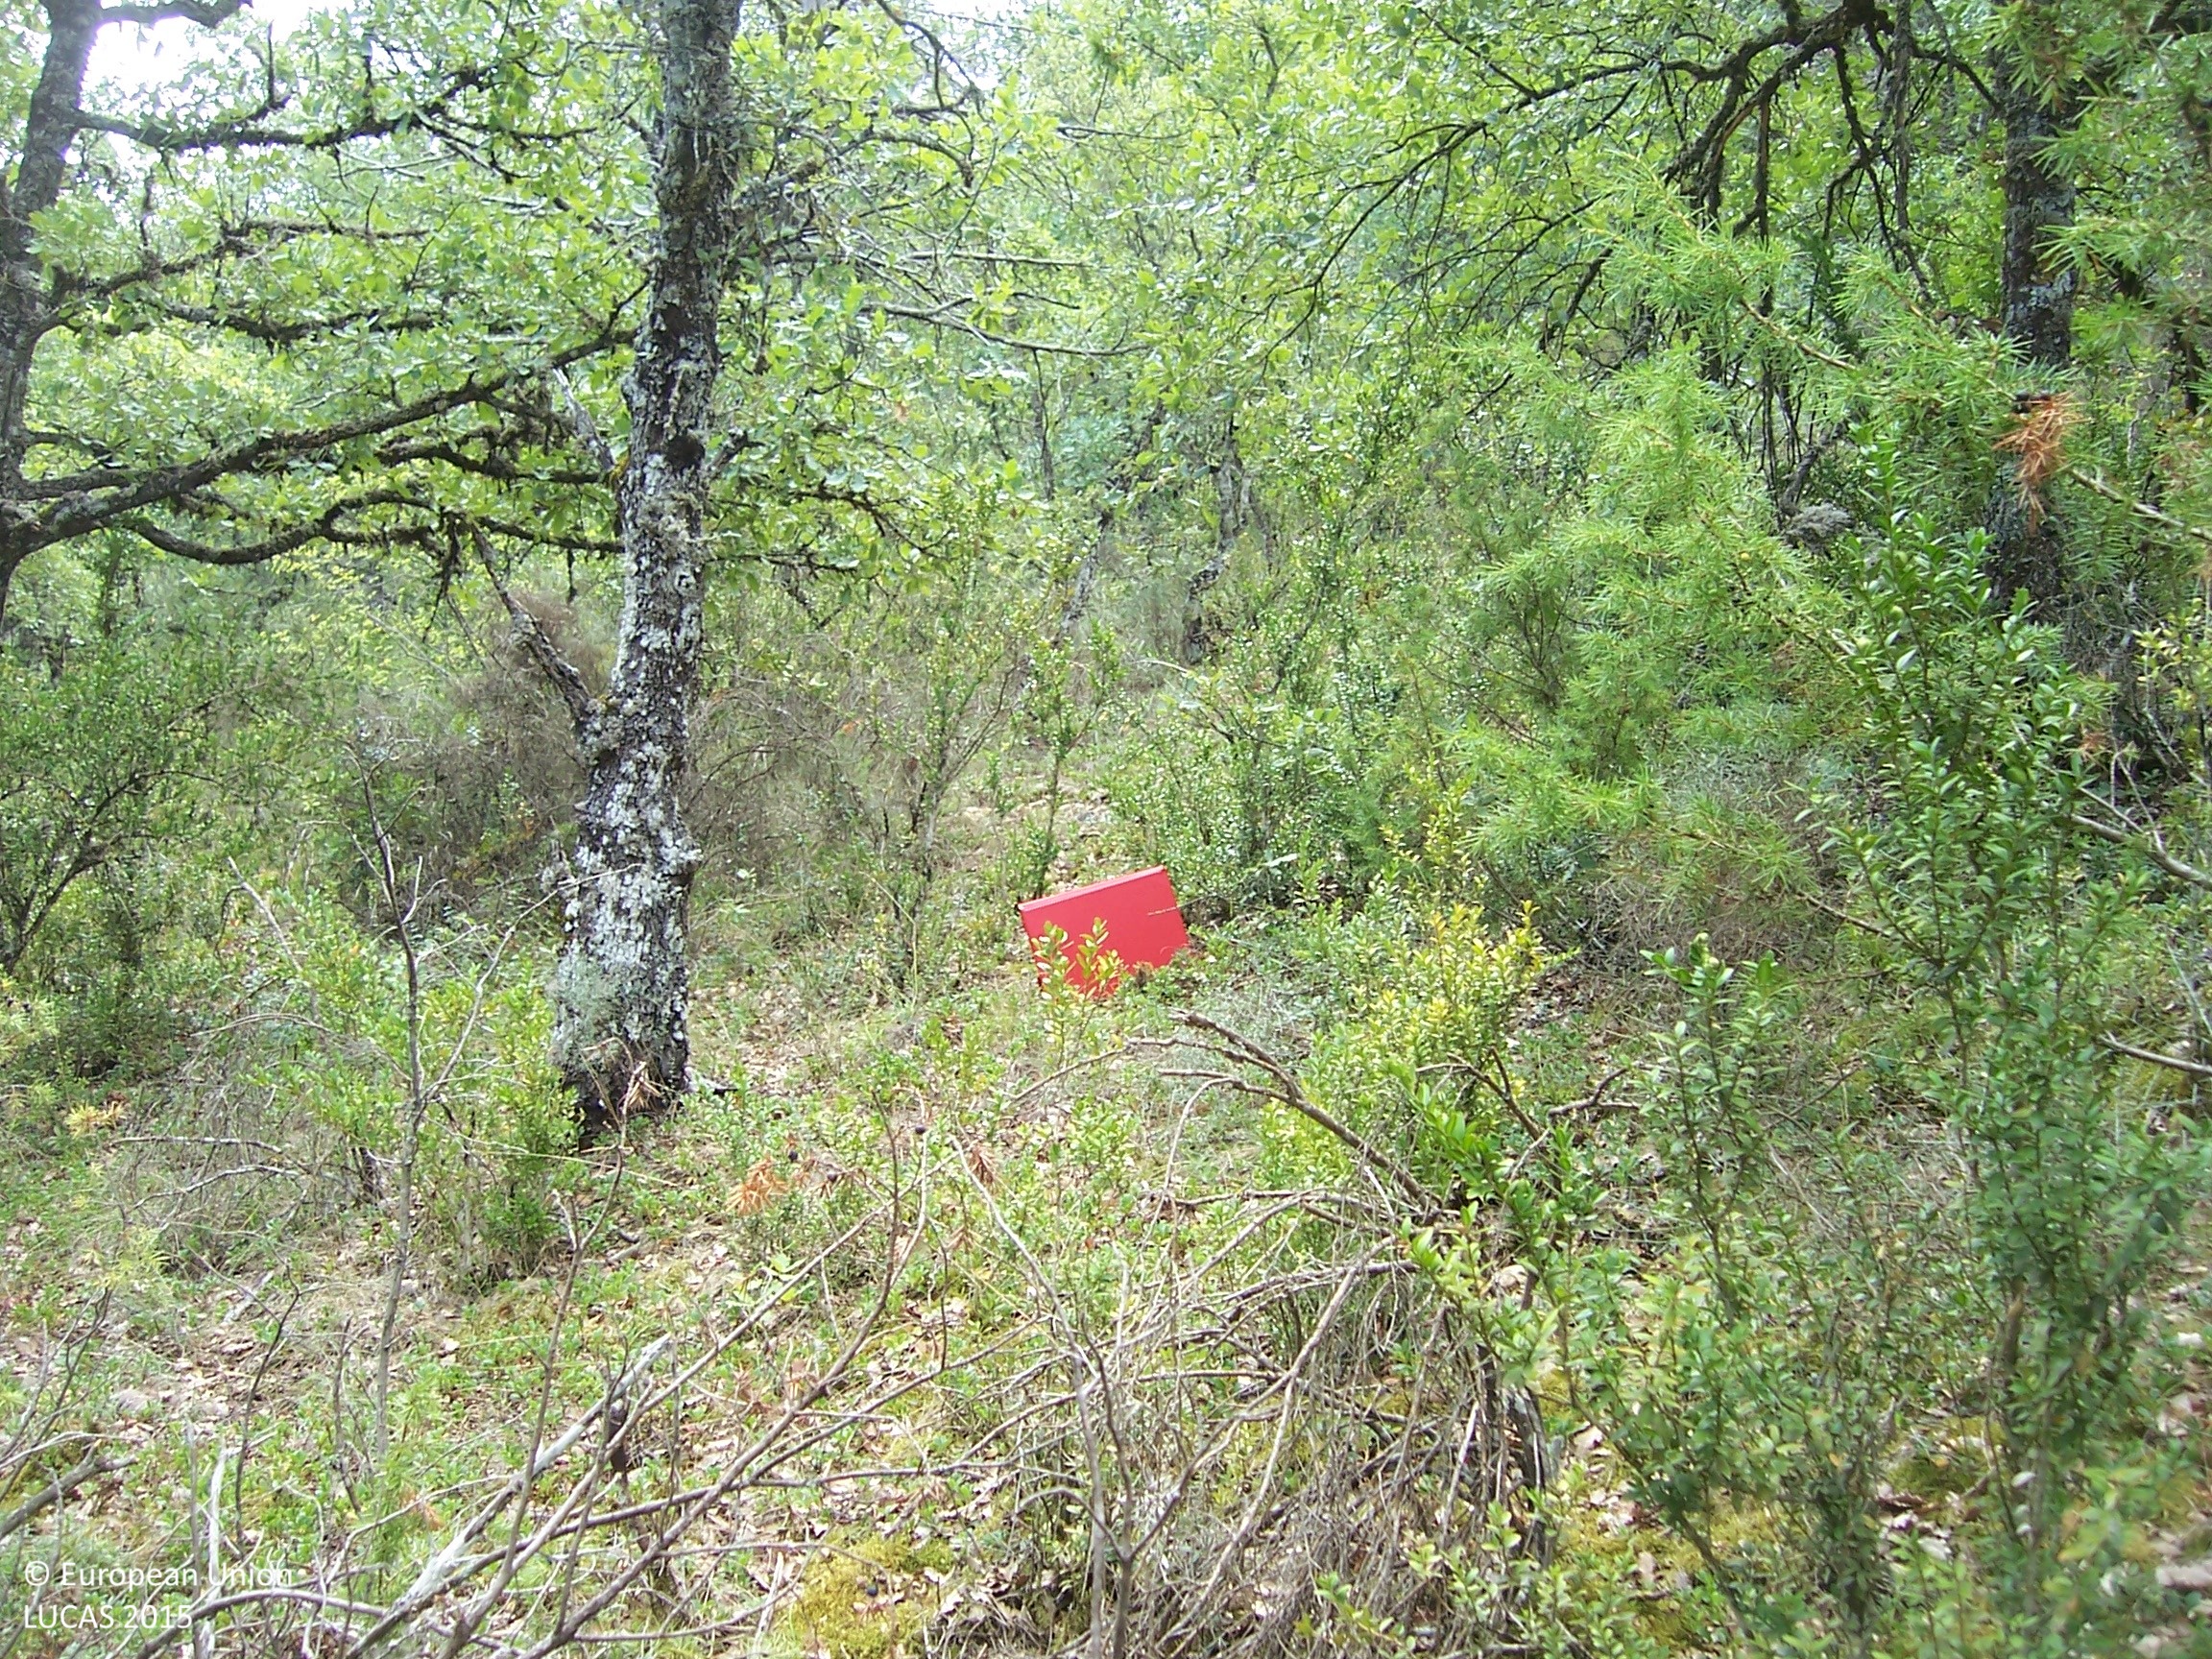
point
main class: Woodland
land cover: Broadleaved woodland
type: broadleaved evergreen forest
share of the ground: > 75 %
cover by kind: broadleaved forest trees 80 %, shrubs 10 %, herbaceous plants 10 %
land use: Semi-natural and natural areas not in use
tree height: > 5 m
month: August
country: ES
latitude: 42.0587
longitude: 0.4735
